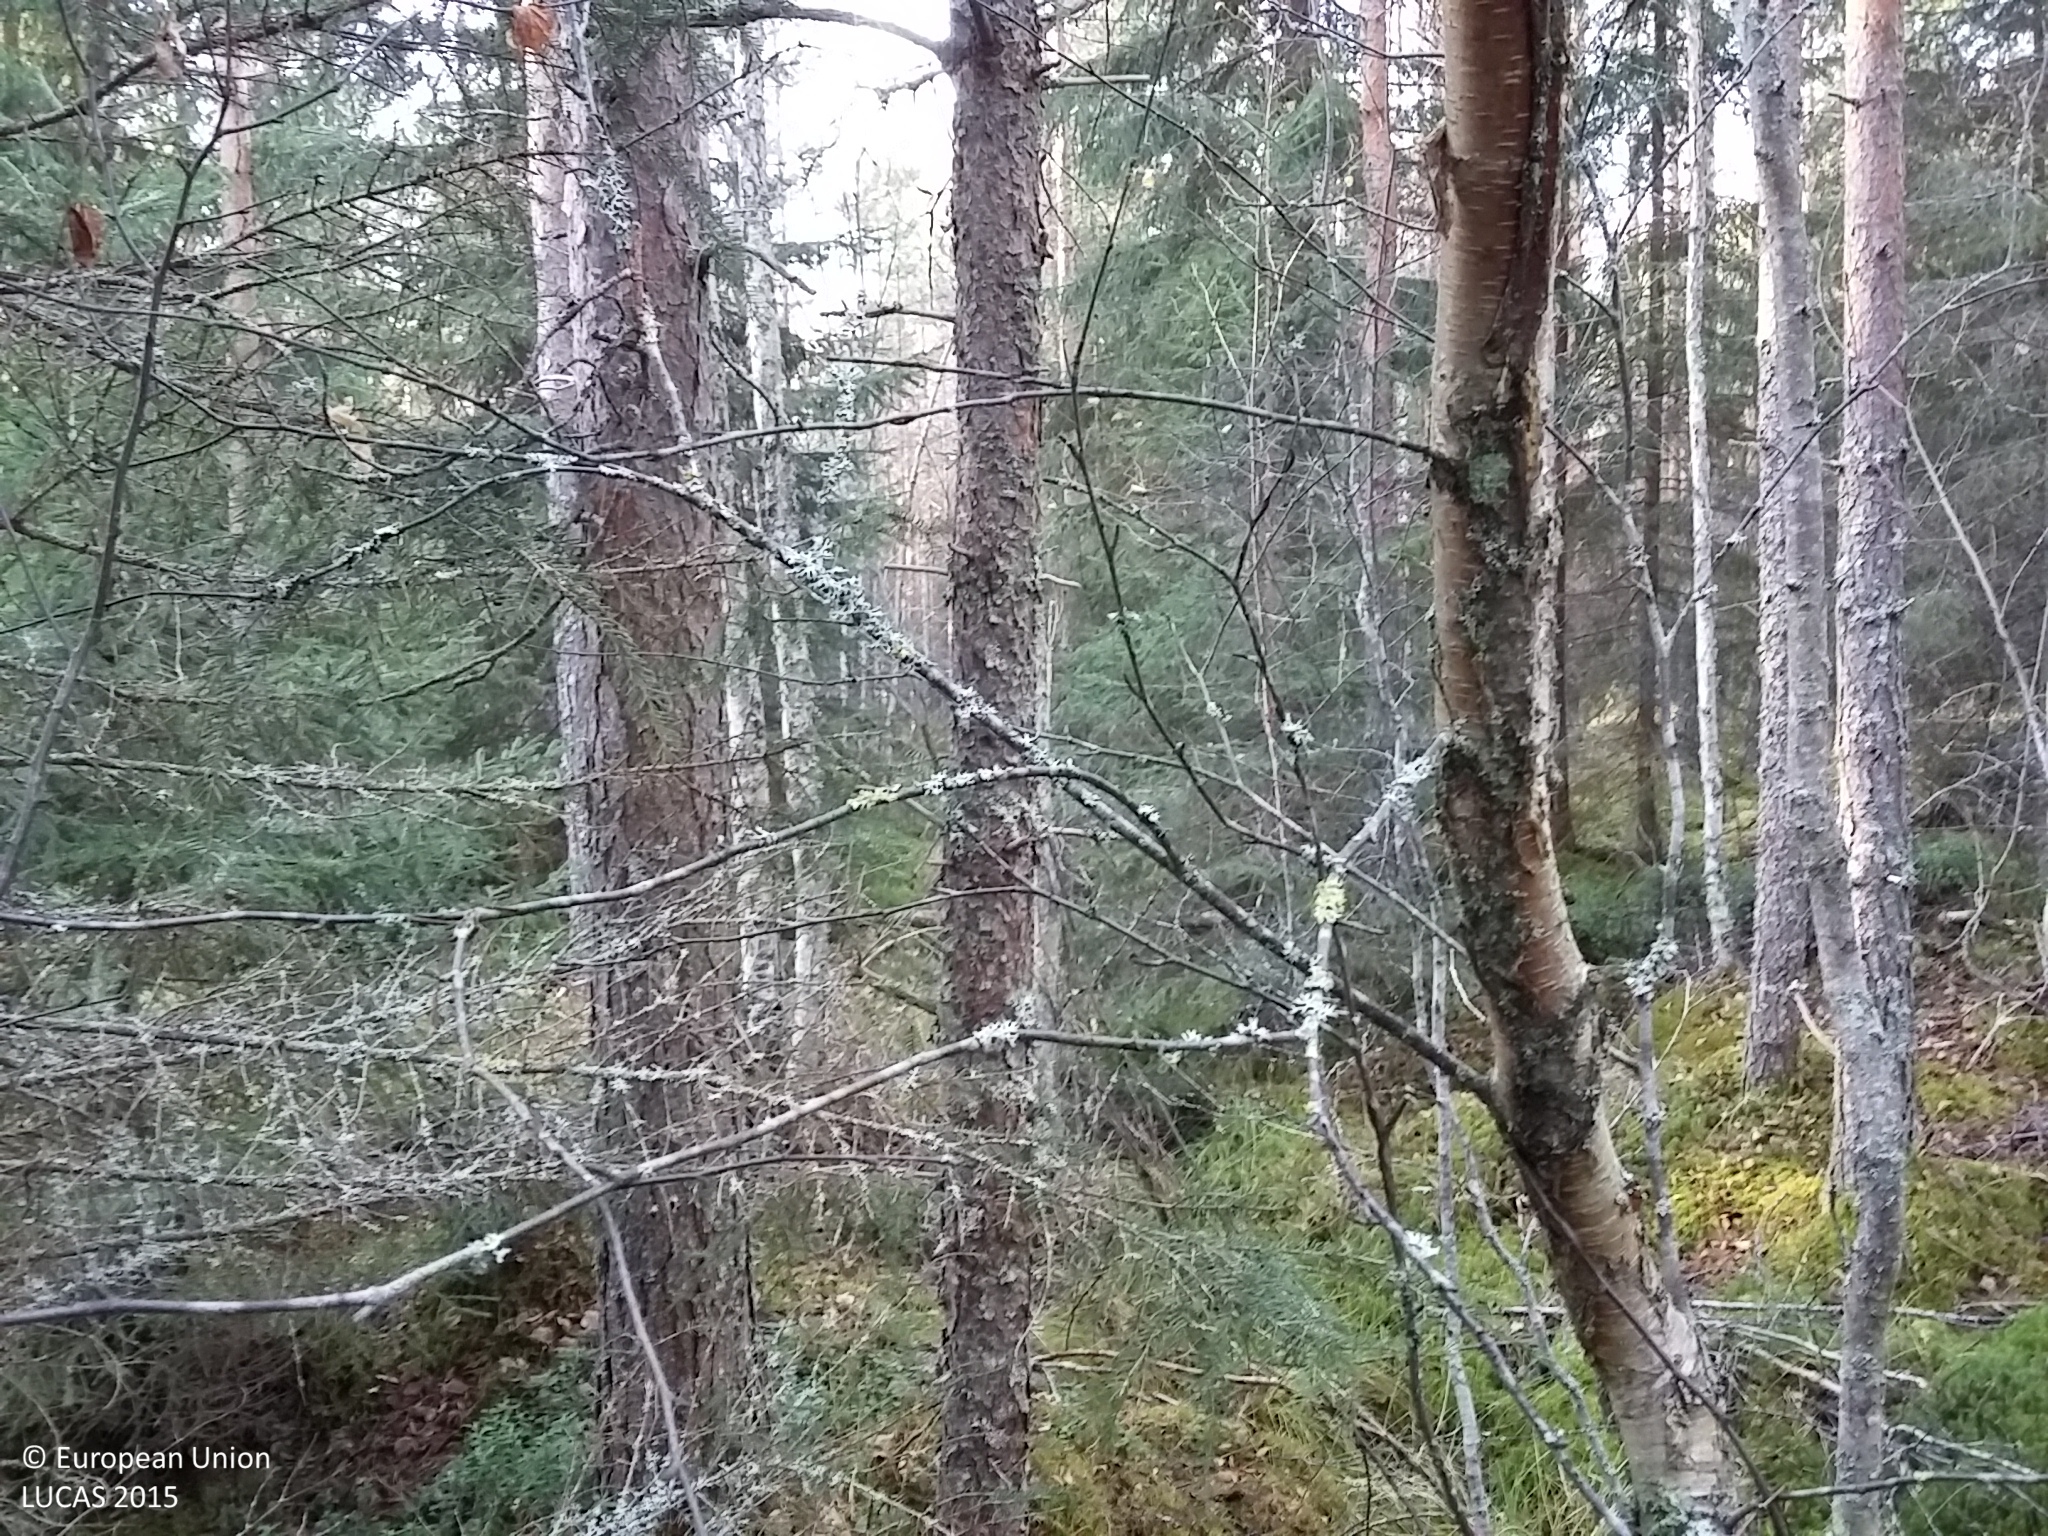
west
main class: Woodland
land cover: Other coniferous woodland
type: boreal forest
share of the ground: > 75 %
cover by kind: coniferous forest trees 80 %, broadleaved forest trees 10 %, herbaceous plants 5 %, lichens and mosses 5 %
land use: Forestry
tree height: > 5 m
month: October
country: FI
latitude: 64.5928
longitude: 25.4839
